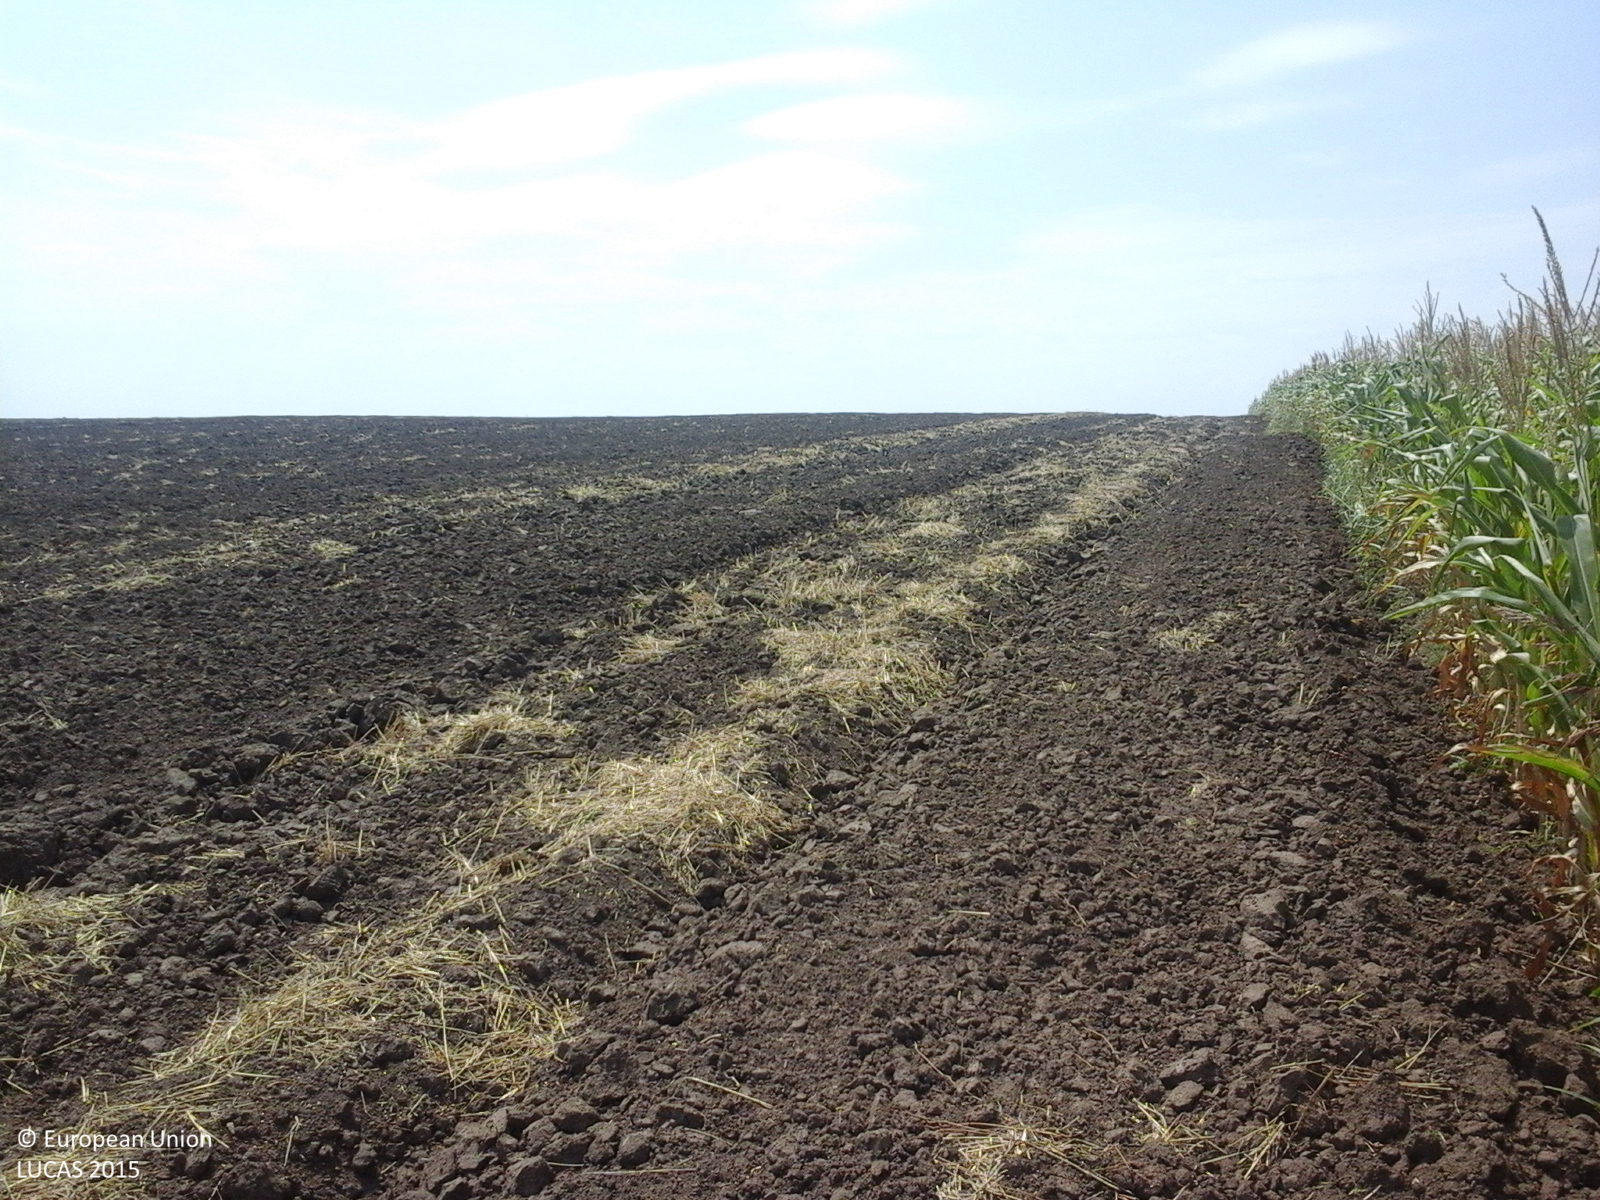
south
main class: Cropland
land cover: Maize
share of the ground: > 75 %
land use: Agriculture (excluding fallow land and kitchen gardens)
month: August
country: RO
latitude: 43.8967
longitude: 28.0415
